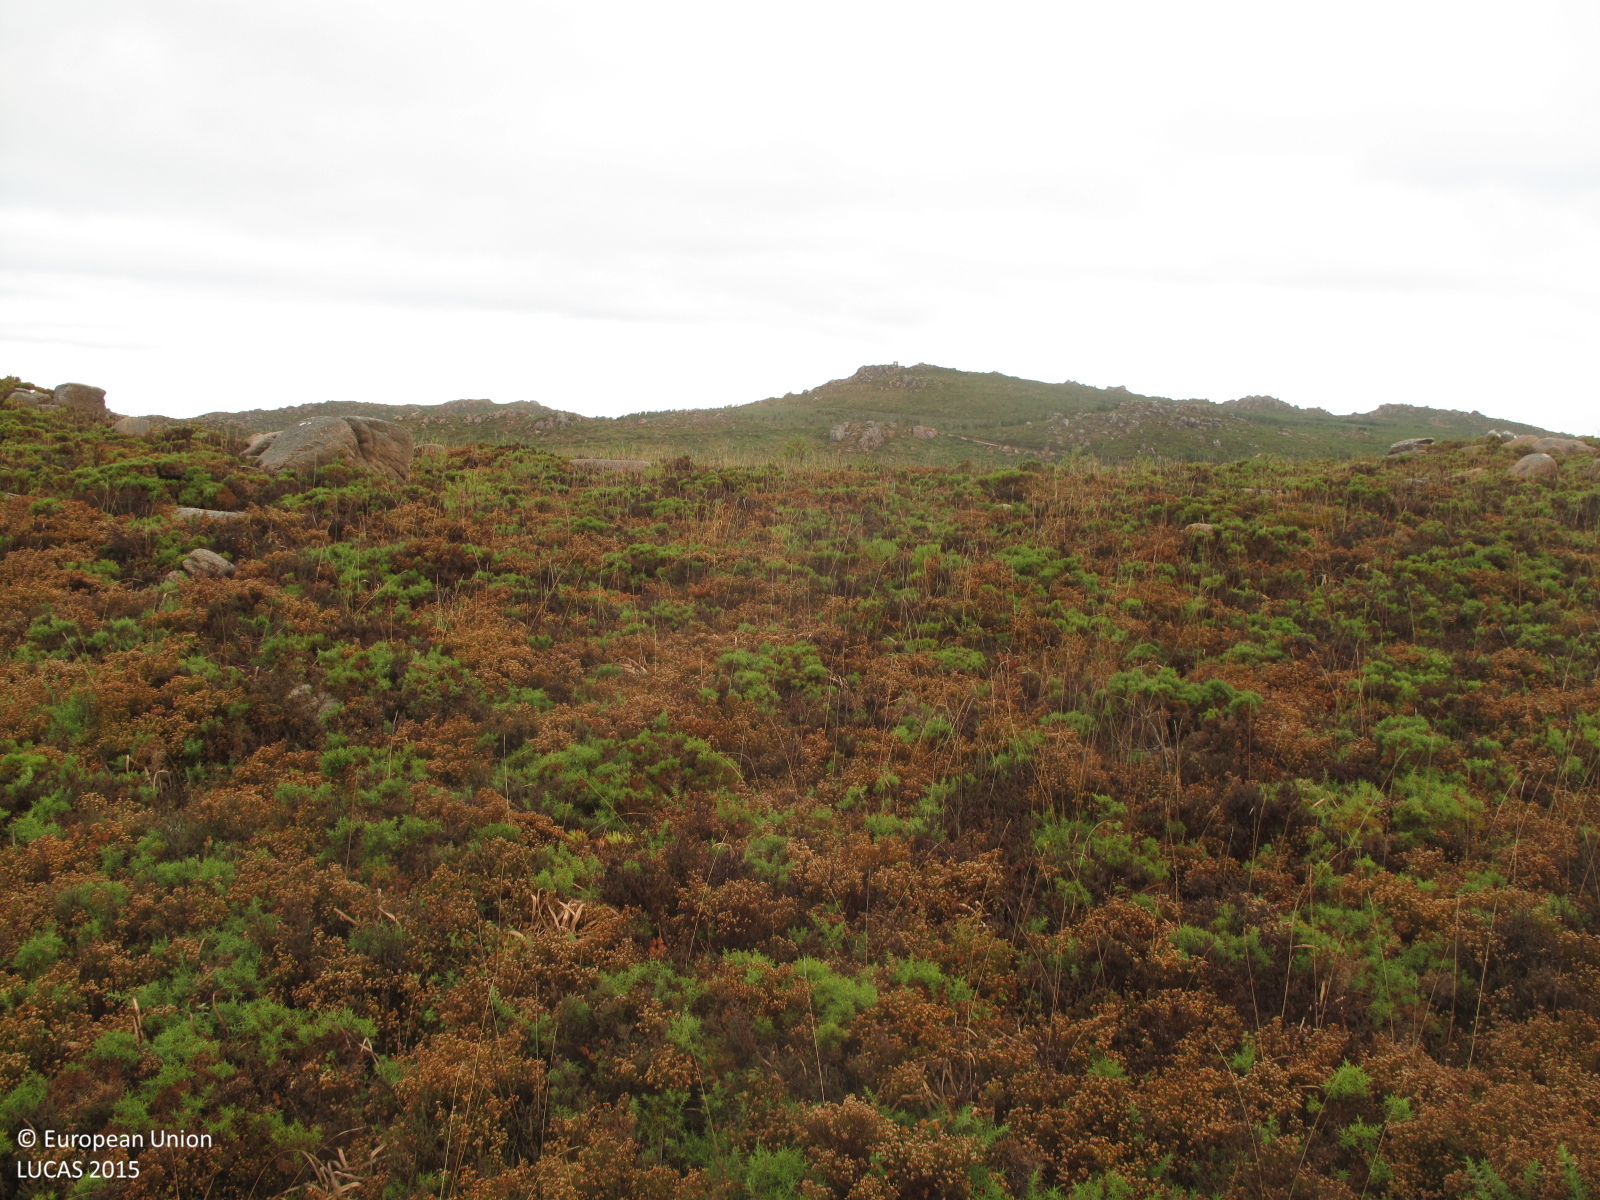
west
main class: Woodland
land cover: Pine dominated coniferous woodland
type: exotic forest
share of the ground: 10 - 25 %
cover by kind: shrubs 70 %, coniferous forest trees 20 %, consolidated bare surface 10 %
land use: Forestry
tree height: < 5 m
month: July
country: ES
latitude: 43.1735
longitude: -9.1592
